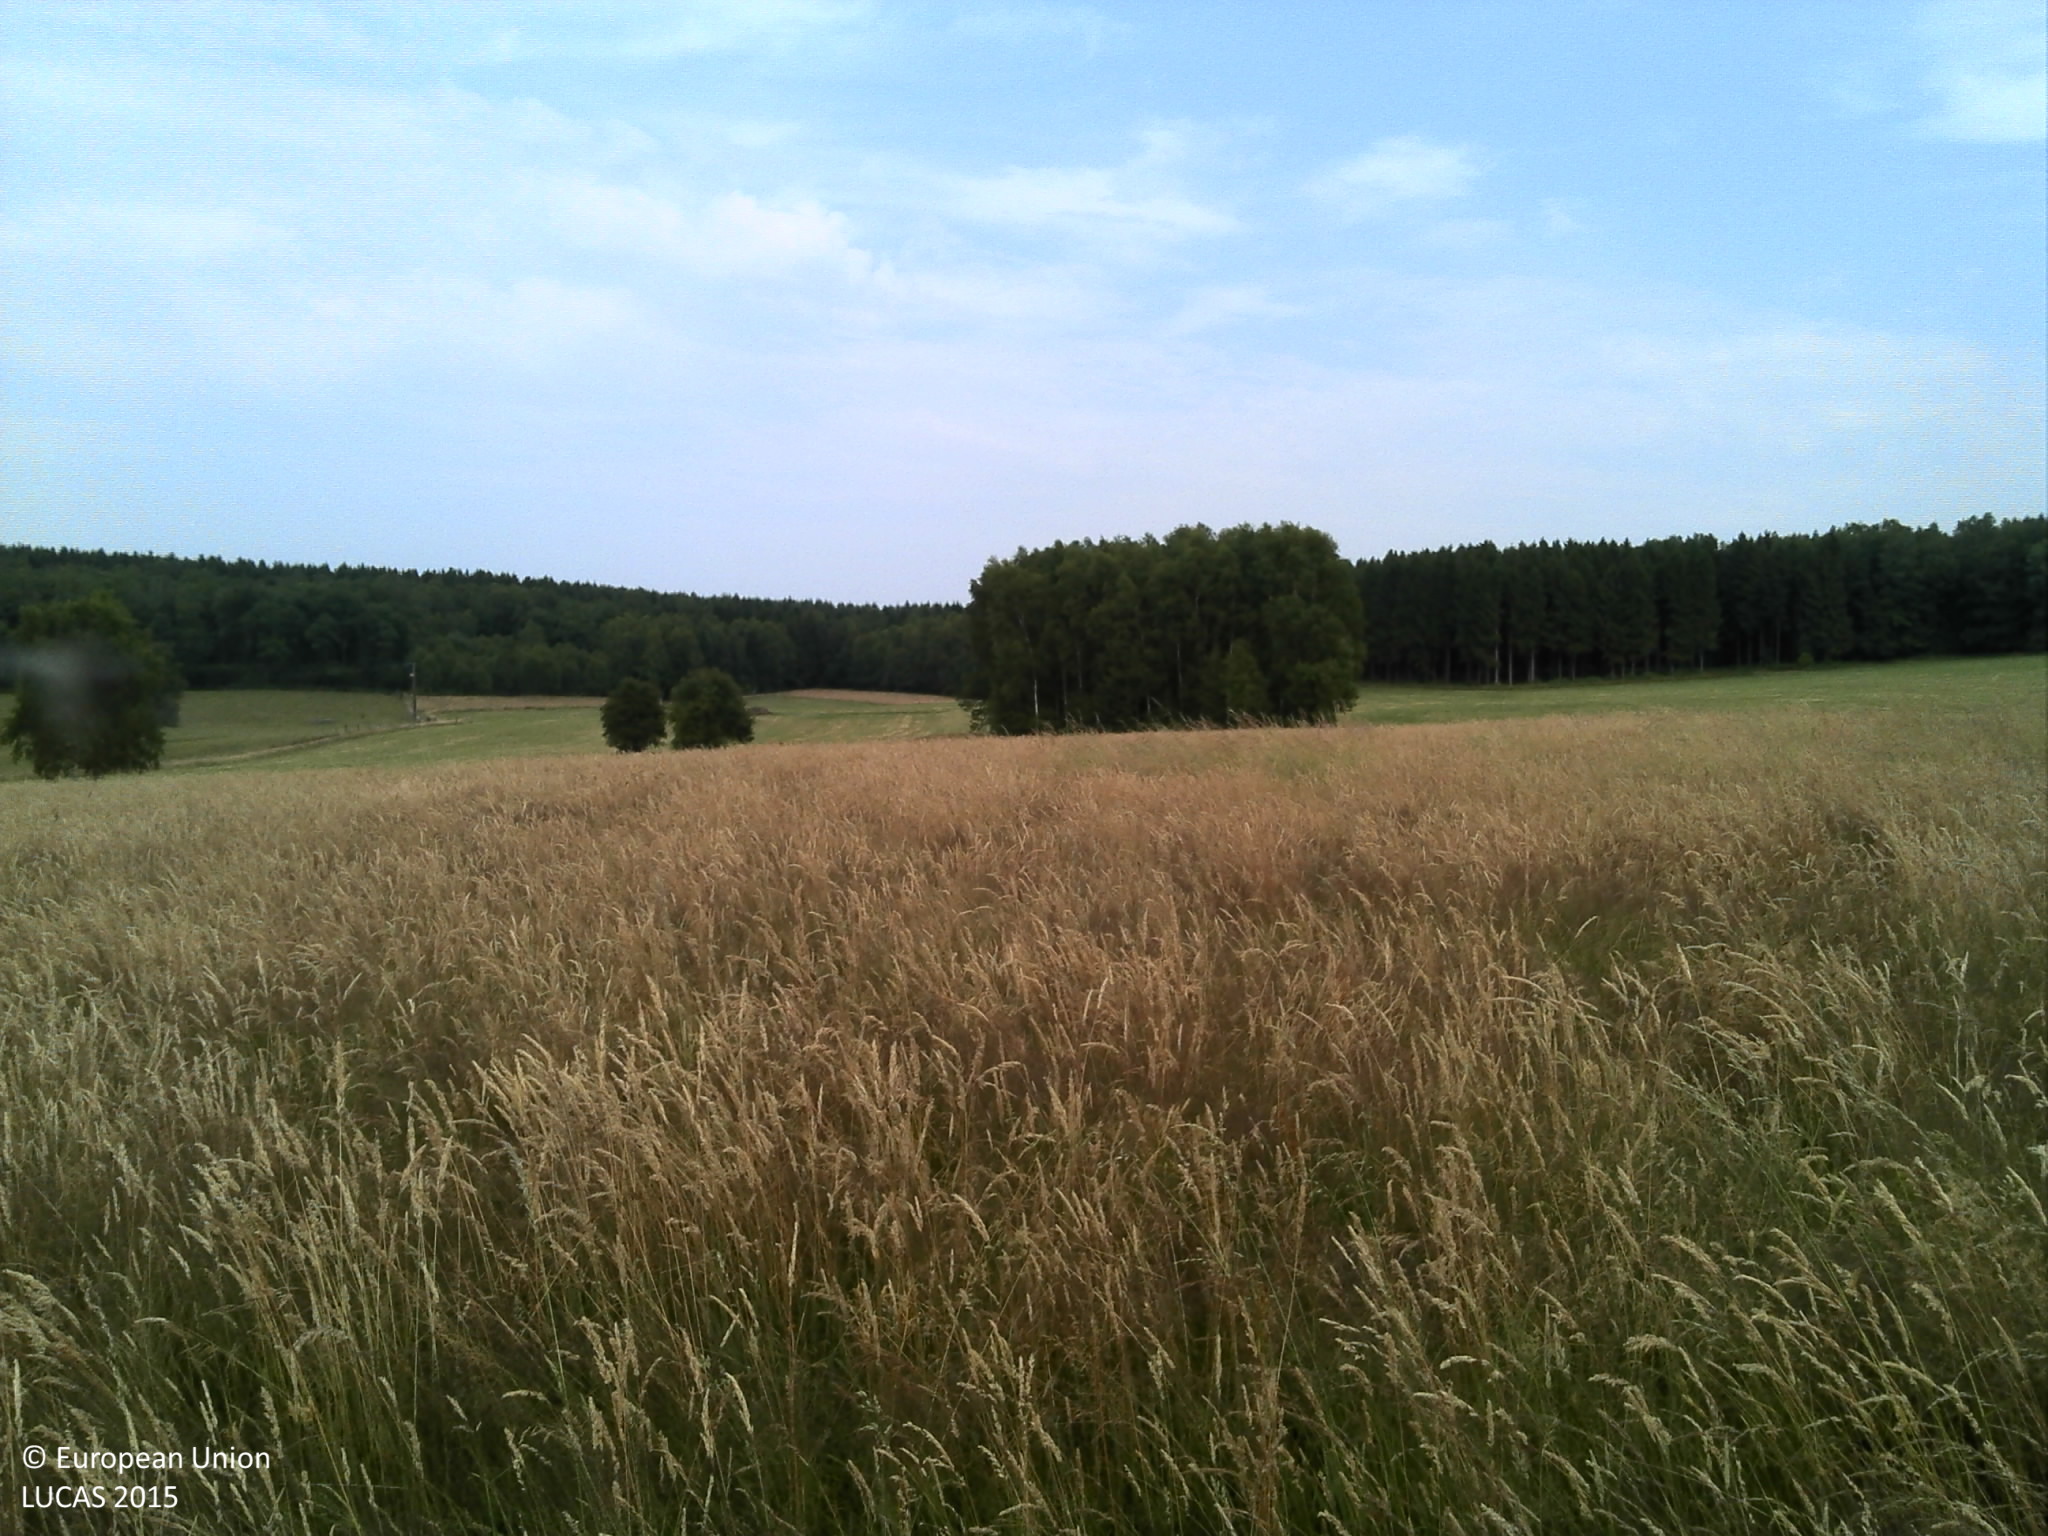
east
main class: Grassland
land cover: Grassland without tree/shrub cover
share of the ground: > 75 %
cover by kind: herbaceous plants 100 %
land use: Agriculture (excluding fallow land and kitchen gardens)
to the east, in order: Grassland without tree/shrub cover; Broadleaved woodland; Fences; Grassland without tree/shrub cover
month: July
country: FR
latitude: 49.8613
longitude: 4.6686
